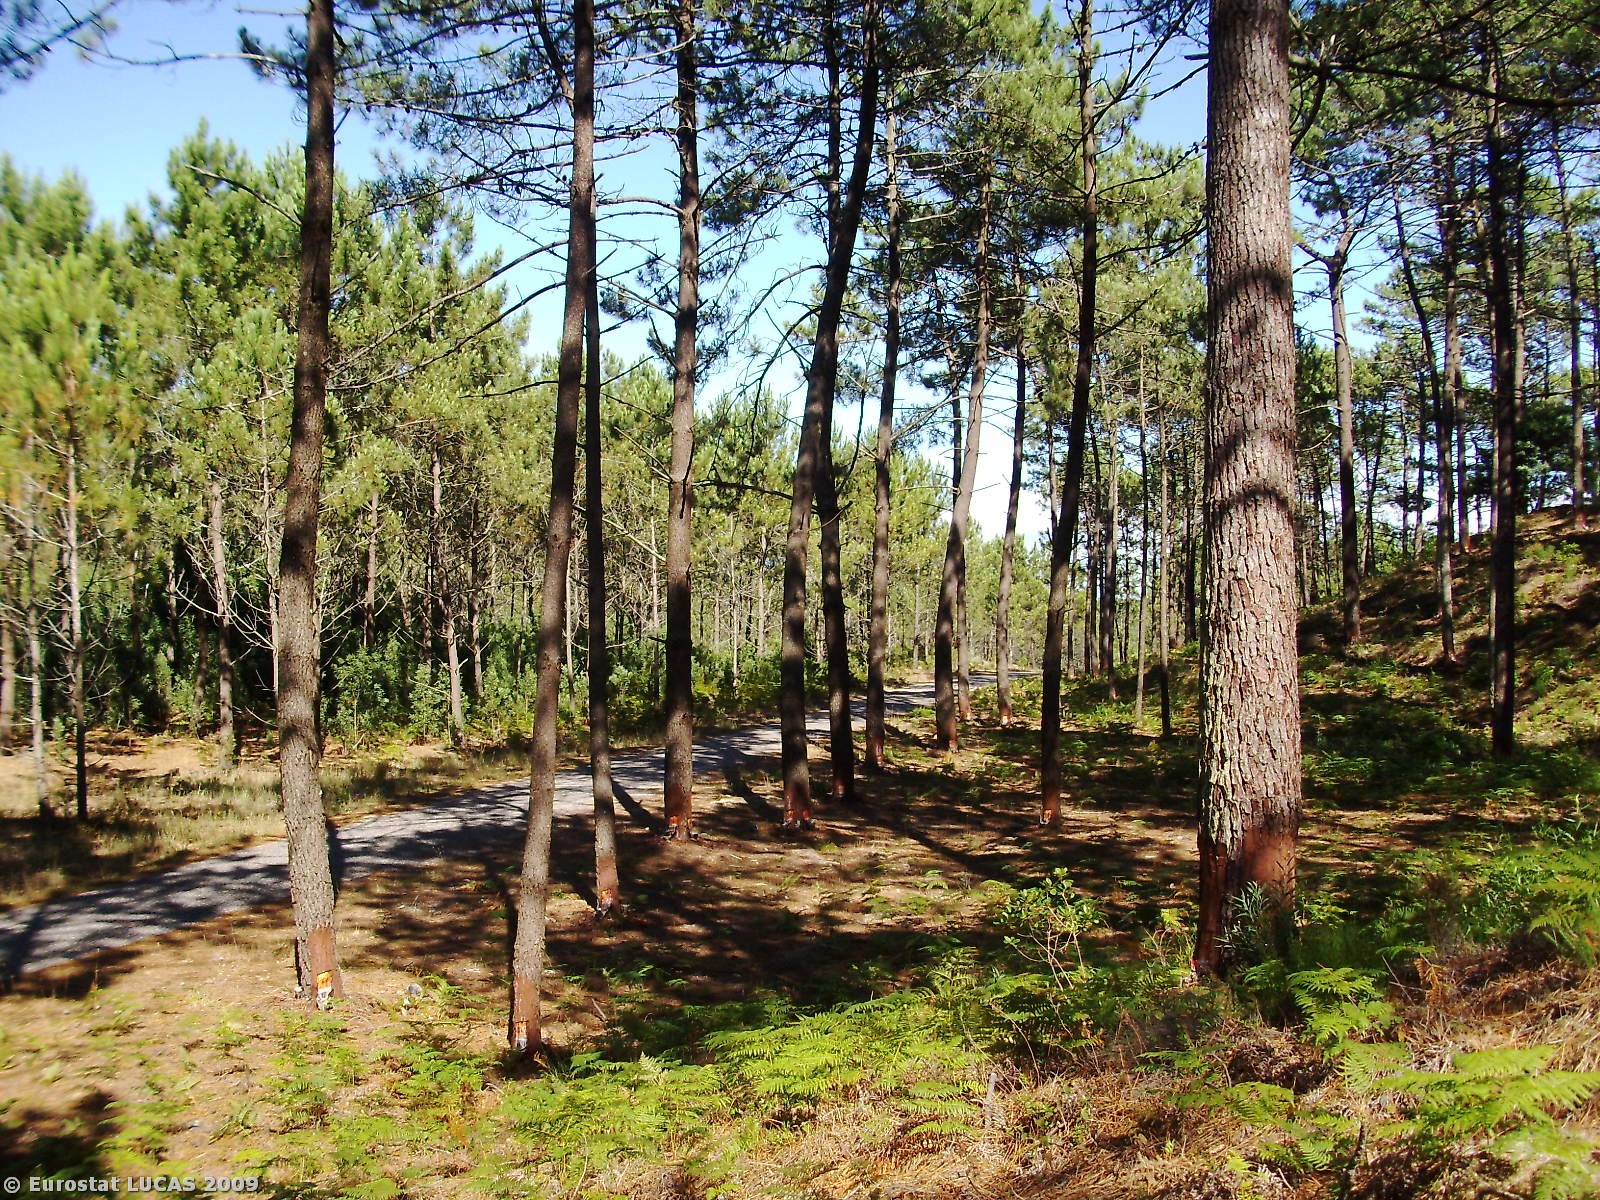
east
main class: Woodland
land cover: Coniferous woodland
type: coniferous forest of the mediterranean region
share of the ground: > 75 %
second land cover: Shrubland with sparse tree cover
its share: 10 - 25 %
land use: Forestry
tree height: > 5 m
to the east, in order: Coniferous woodland; Shrubland with sparse tree cover; Coniferous woodland; Paved roads, cycling and walking lanes; Coniferous woodland; Shrubland with sparse tree cover; Tracks; Coniferous woodland
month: July
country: PT
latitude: 39.7244
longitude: -9.0027
